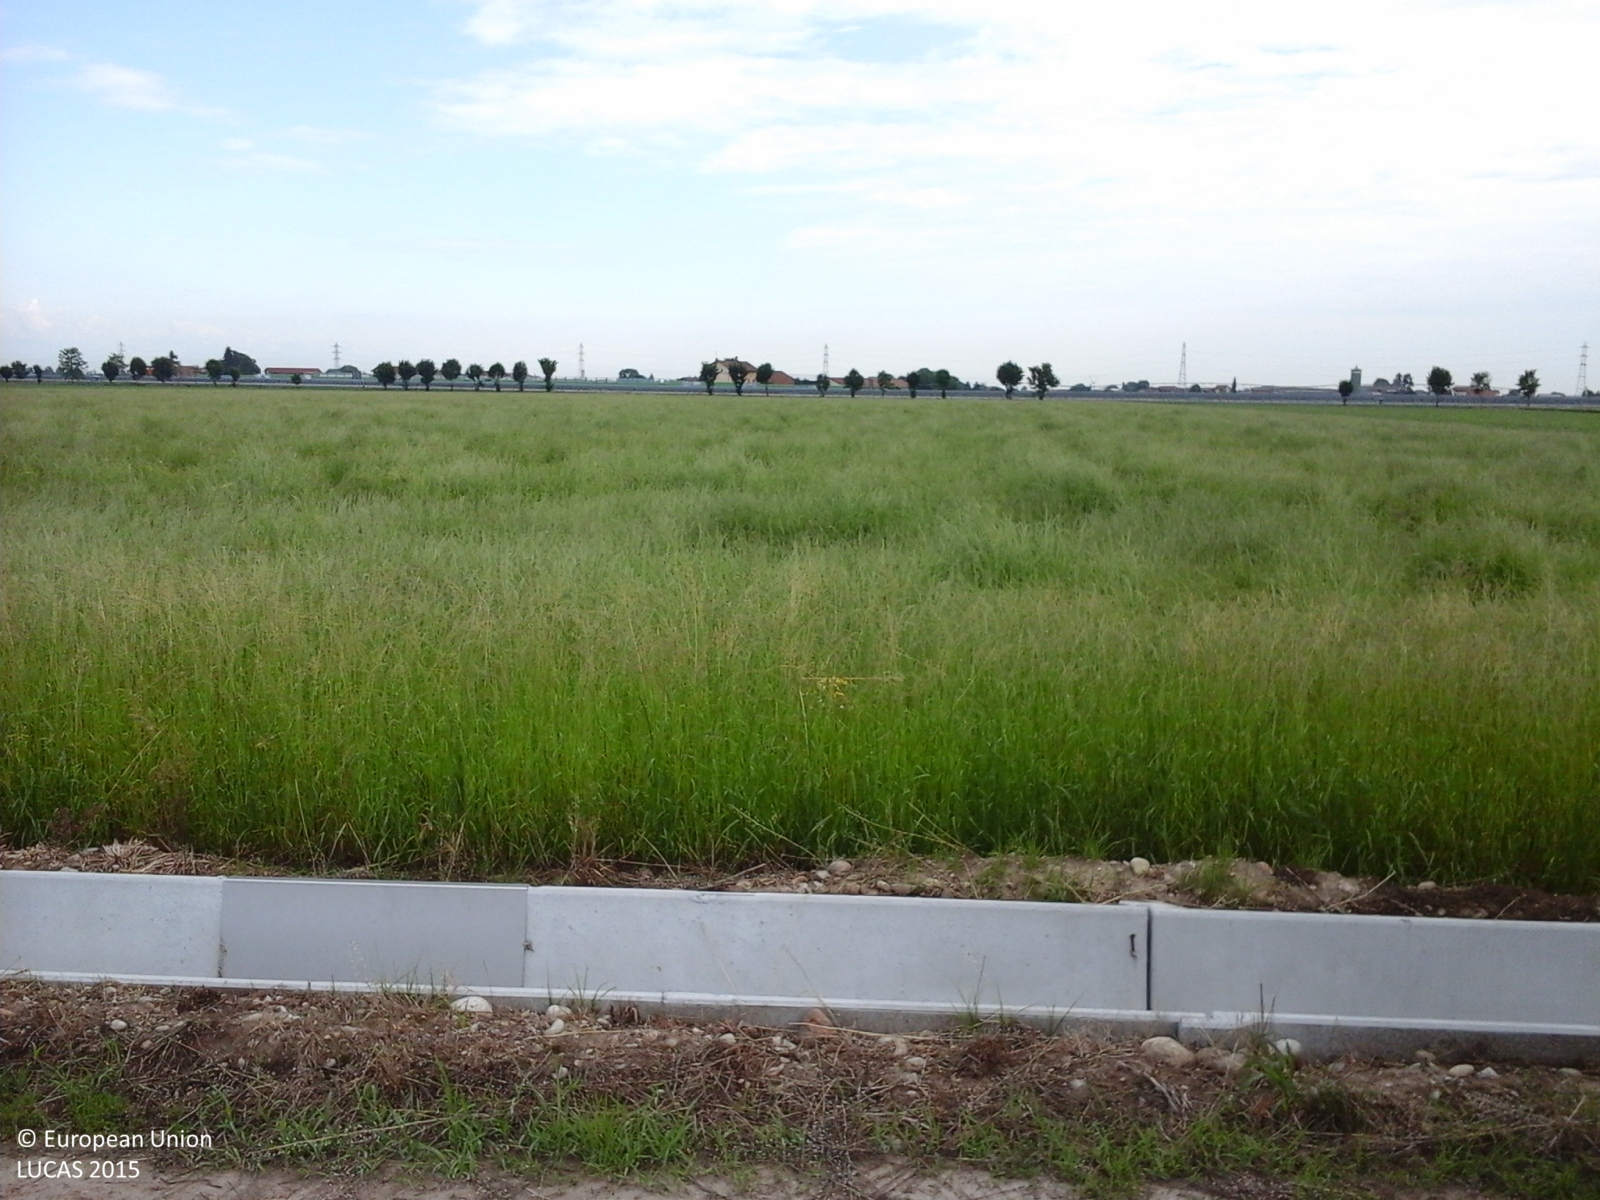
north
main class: Cropland
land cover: Barley
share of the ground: > 75 %
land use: Agriculture (excluding fallow land and kitchen gardens)
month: May
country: IT
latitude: 44.4695
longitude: 7.7044
